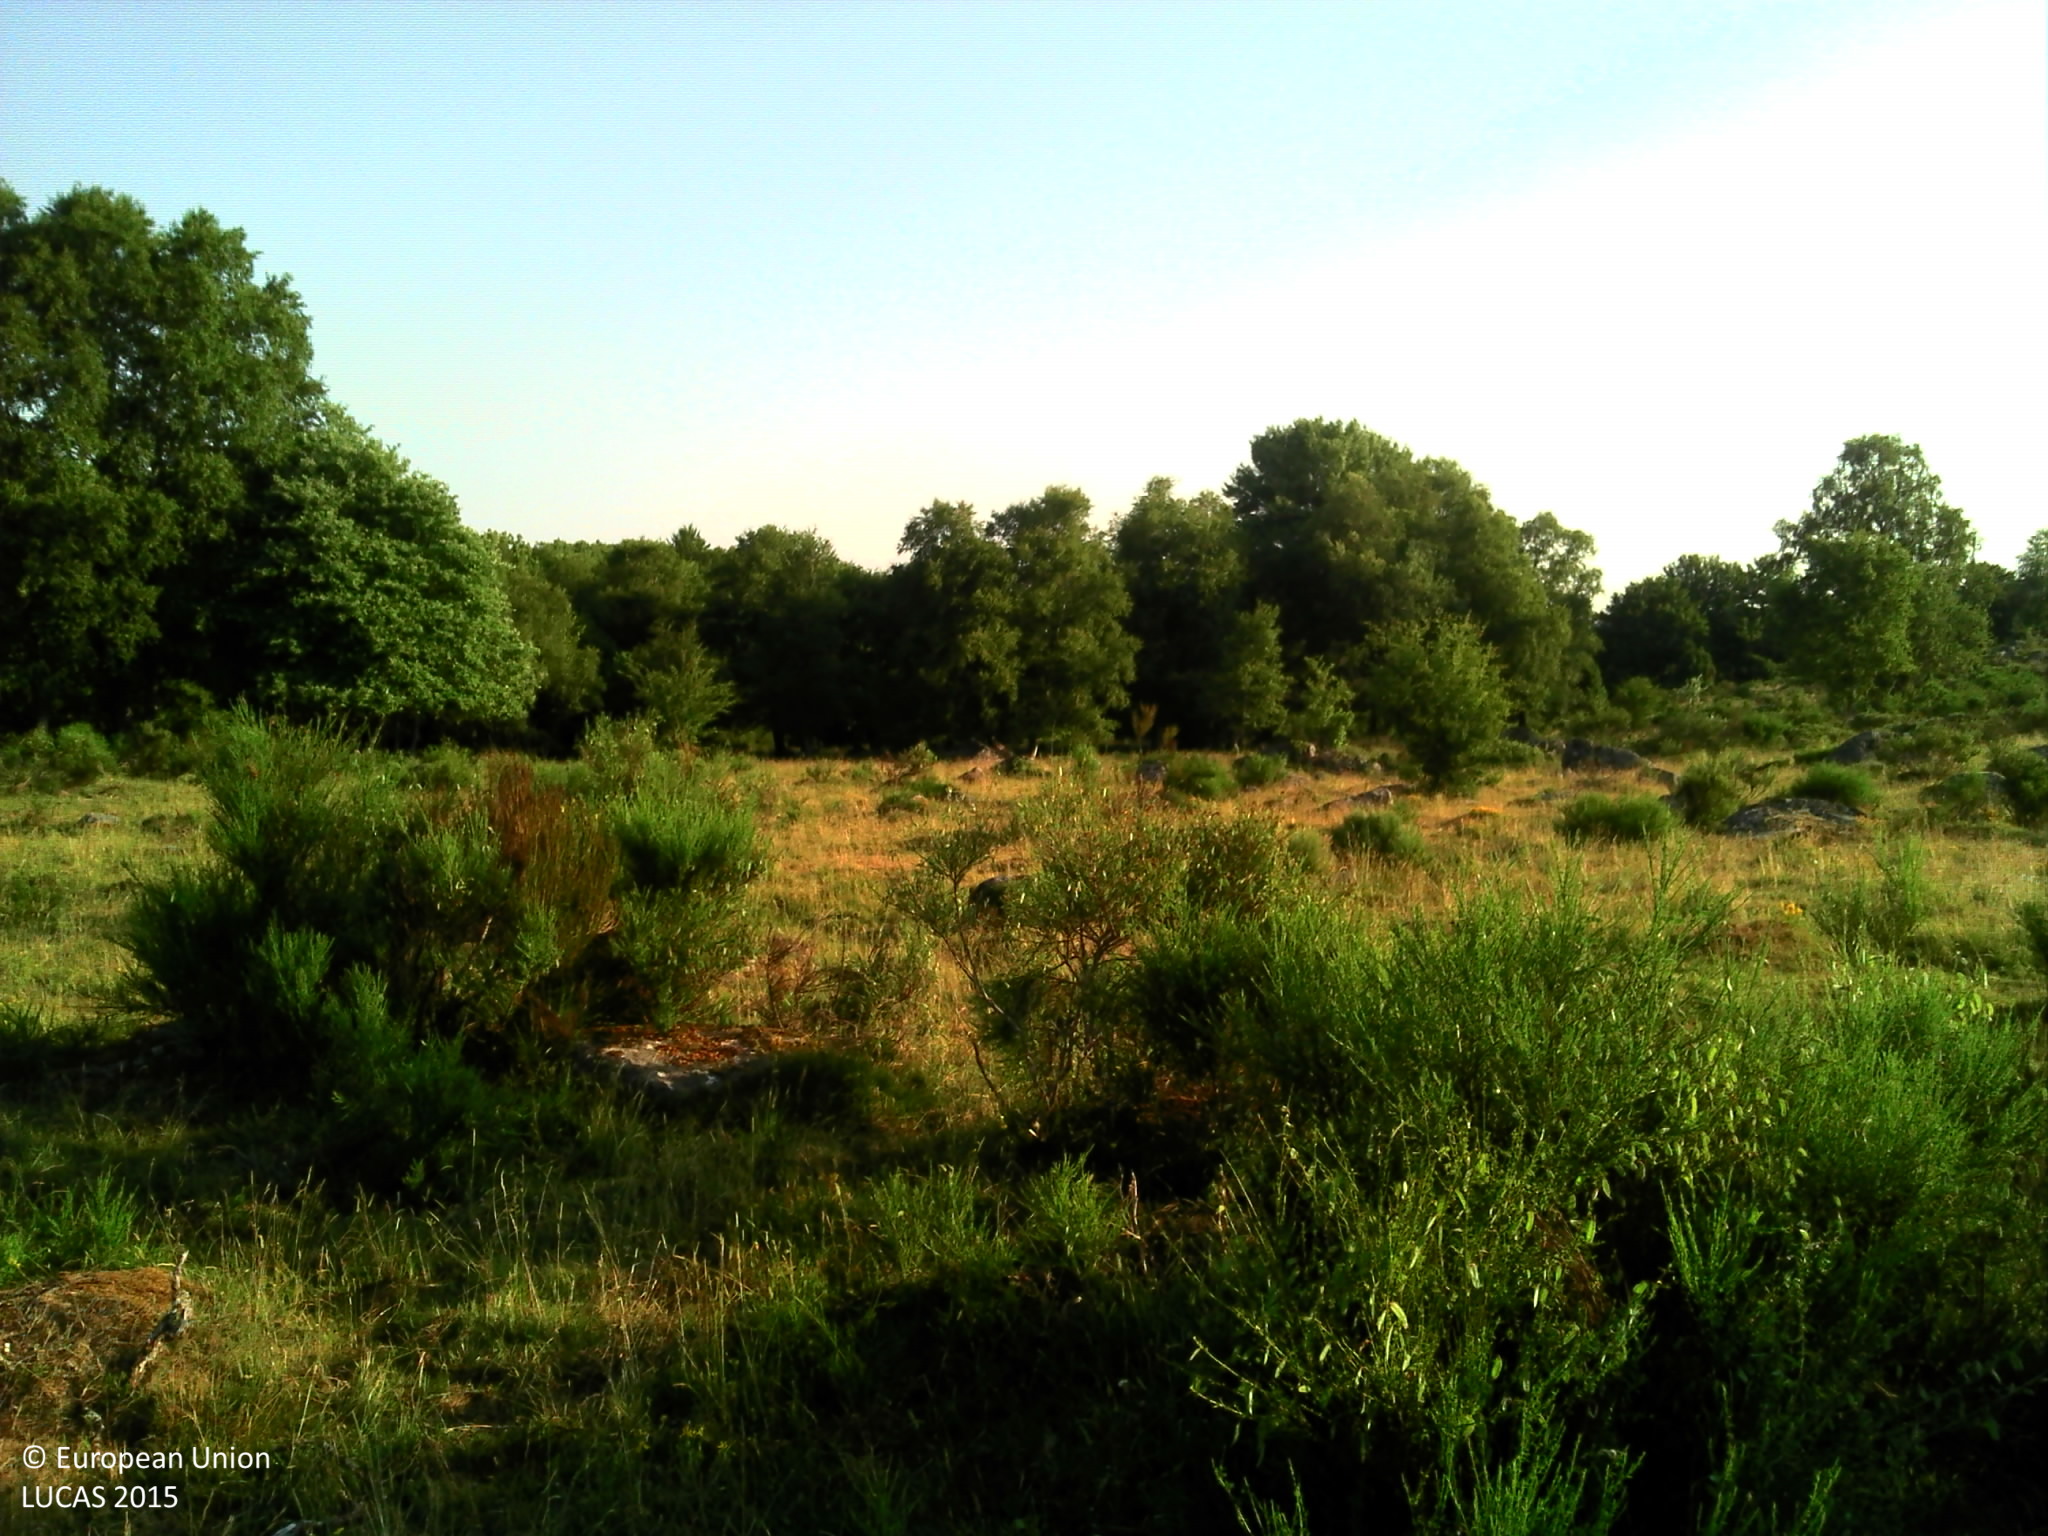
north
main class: Shrubland
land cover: Shrubland without tree cover
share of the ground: > 75 %
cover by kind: herbaceous plants 80 %, shrubs 20 %
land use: Agriculture (excluding fallow land and kitchen gardens)
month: July
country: FR
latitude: 44.7452
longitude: 2.9681
